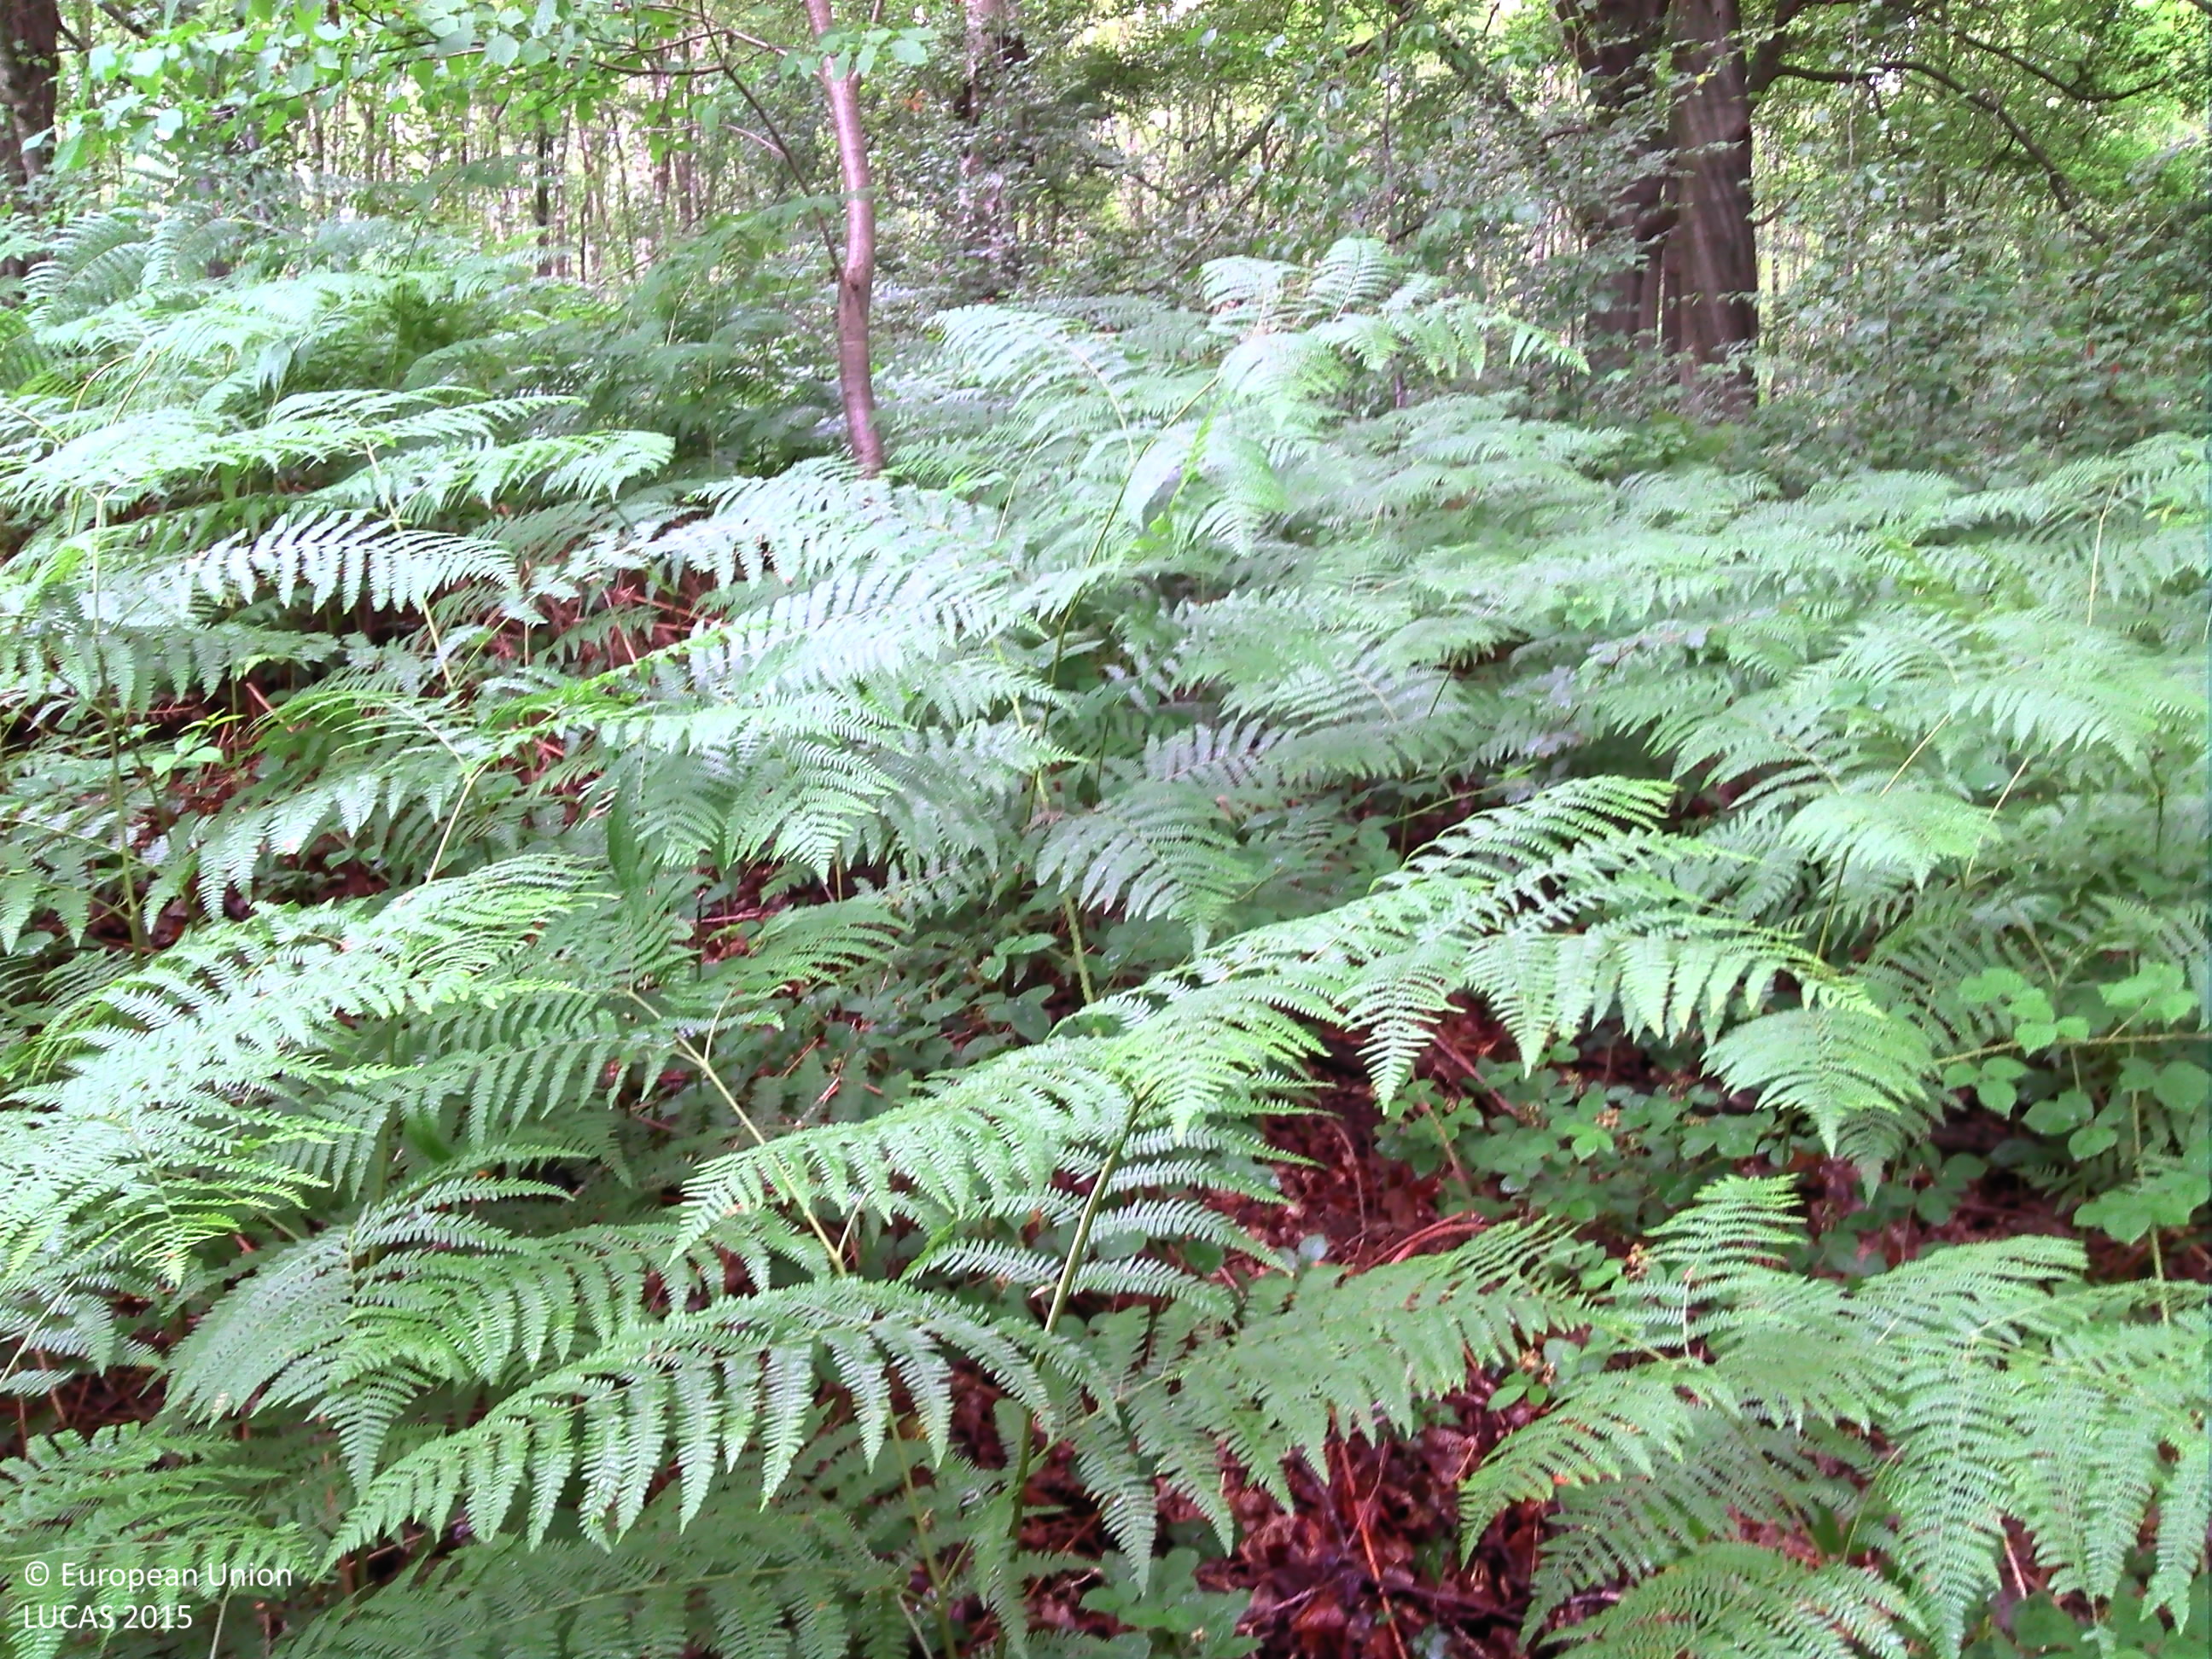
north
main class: Woodland
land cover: Broadleaved woodland
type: acidophilous oak and oak-birch forest
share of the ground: > 75 %
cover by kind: broadleaved forest trees 80 %, herbaceous plants 20 %
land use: Forestry
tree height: > 5 m
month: July
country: BE
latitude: 50.5265
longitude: 5.4700
